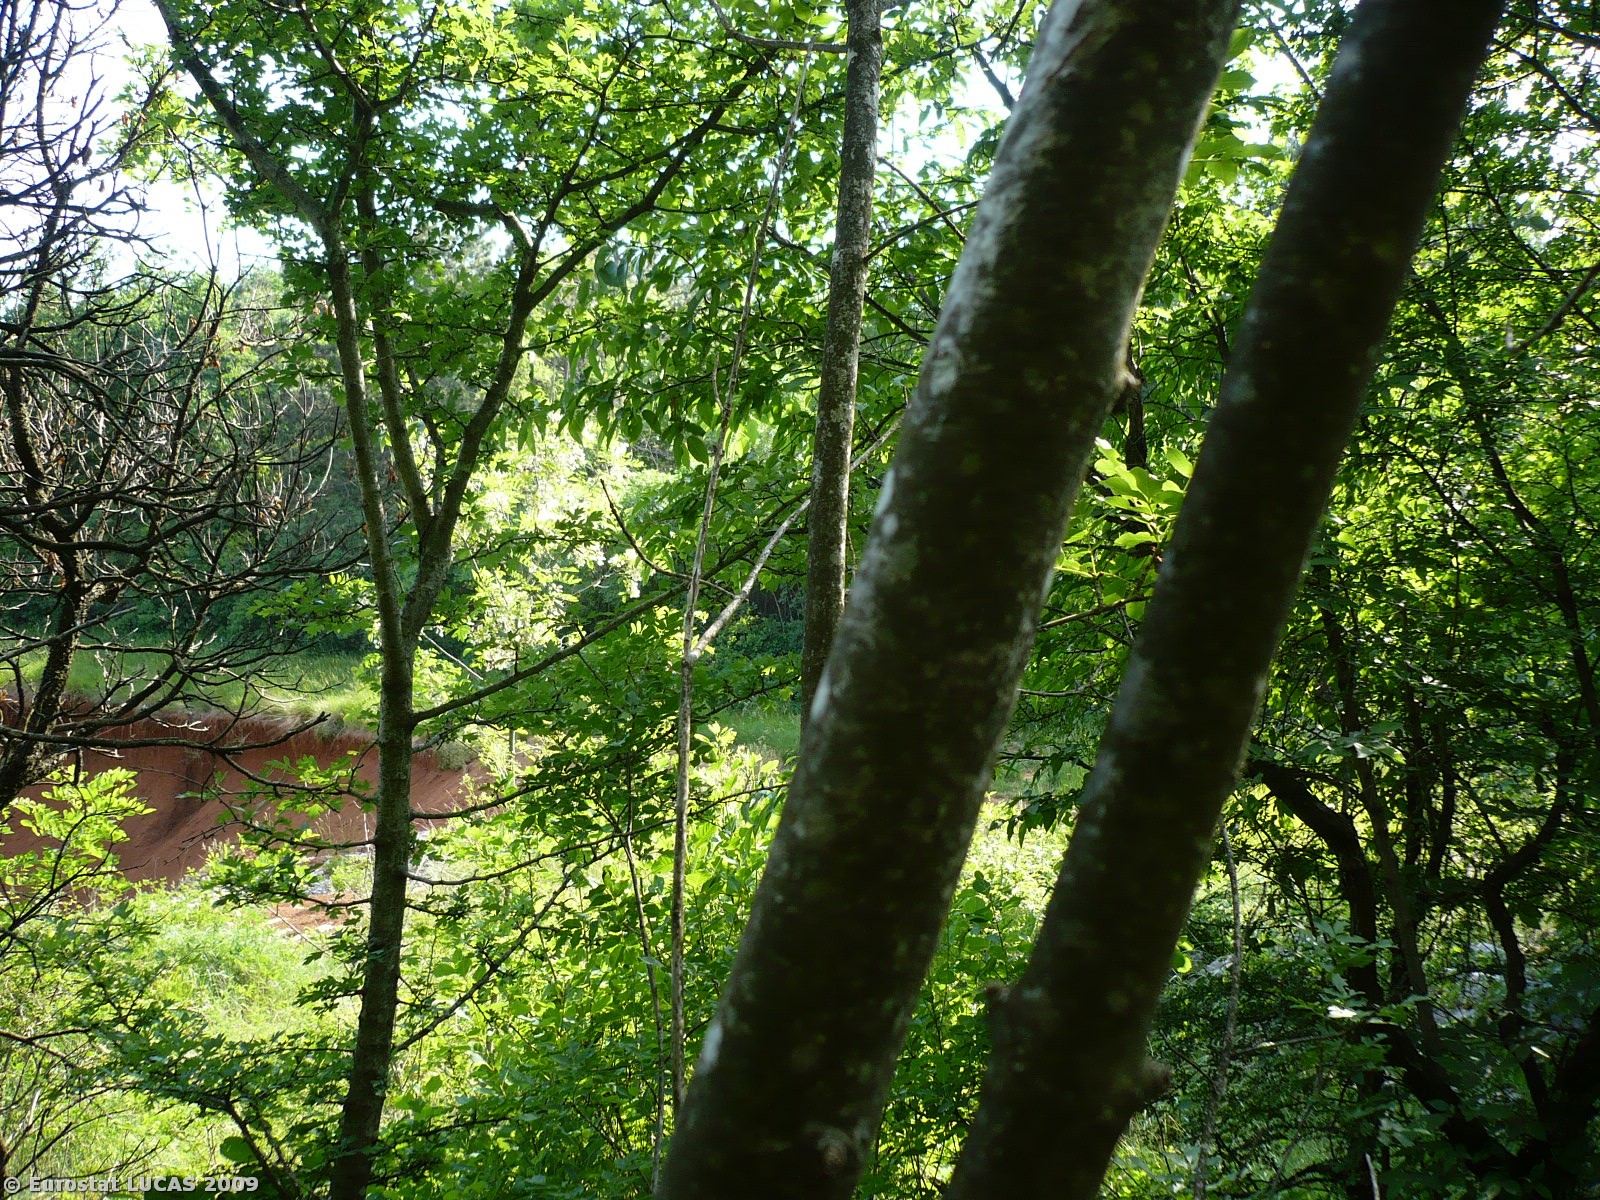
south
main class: Woodland
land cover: Broadleaved woodland
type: thermophilous deciduous forest
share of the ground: > 75 %
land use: Unused
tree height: > 5 m
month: May
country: SI
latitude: 45.8376
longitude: 13.6653
